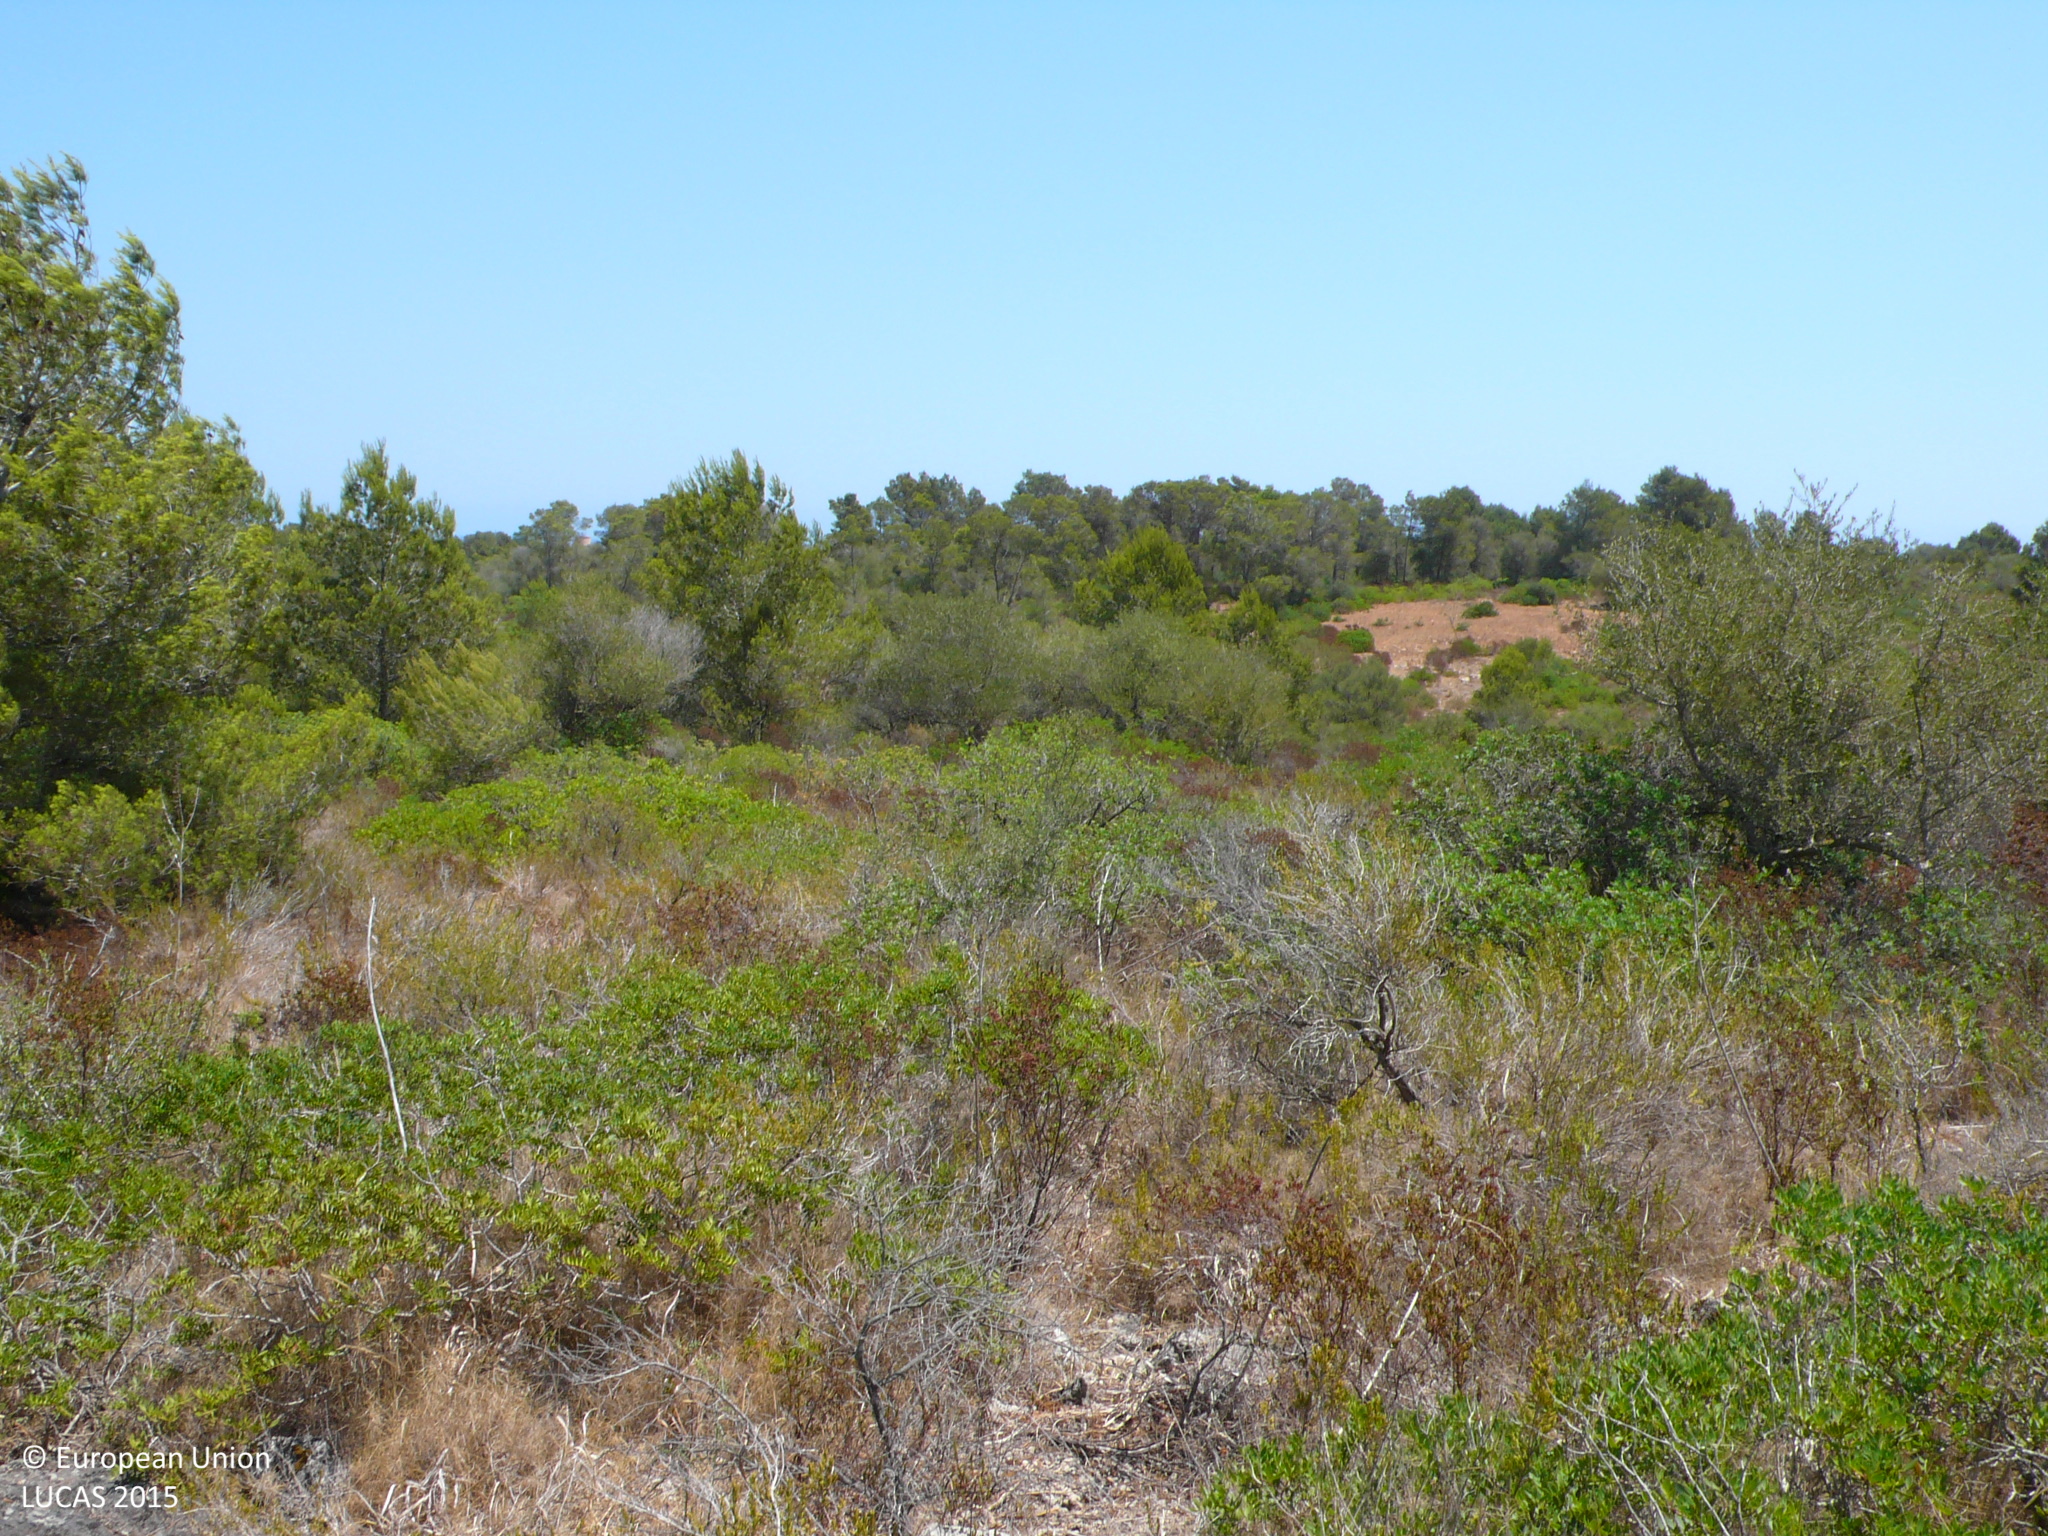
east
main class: Woodland
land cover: Pine dominated mixed woodland
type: coniferous forest of the mediterranean region
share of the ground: 50 - 75 %
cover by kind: shrubs 40 %, coniferous forest trees 35 %, broadleaved forest trees 15 %, consolidated bare surface 10 %
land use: Semi-natural and natural areas not in use
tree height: > 5 m
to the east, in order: Pine dominated mixed woodland; Tracks; Pine dominated mixed woodland; Tracks; Pine dominated mixed woodland; Fences; Pine dominated mixed woodland
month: July
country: ES
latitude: 39.5276
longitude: 3.2711
